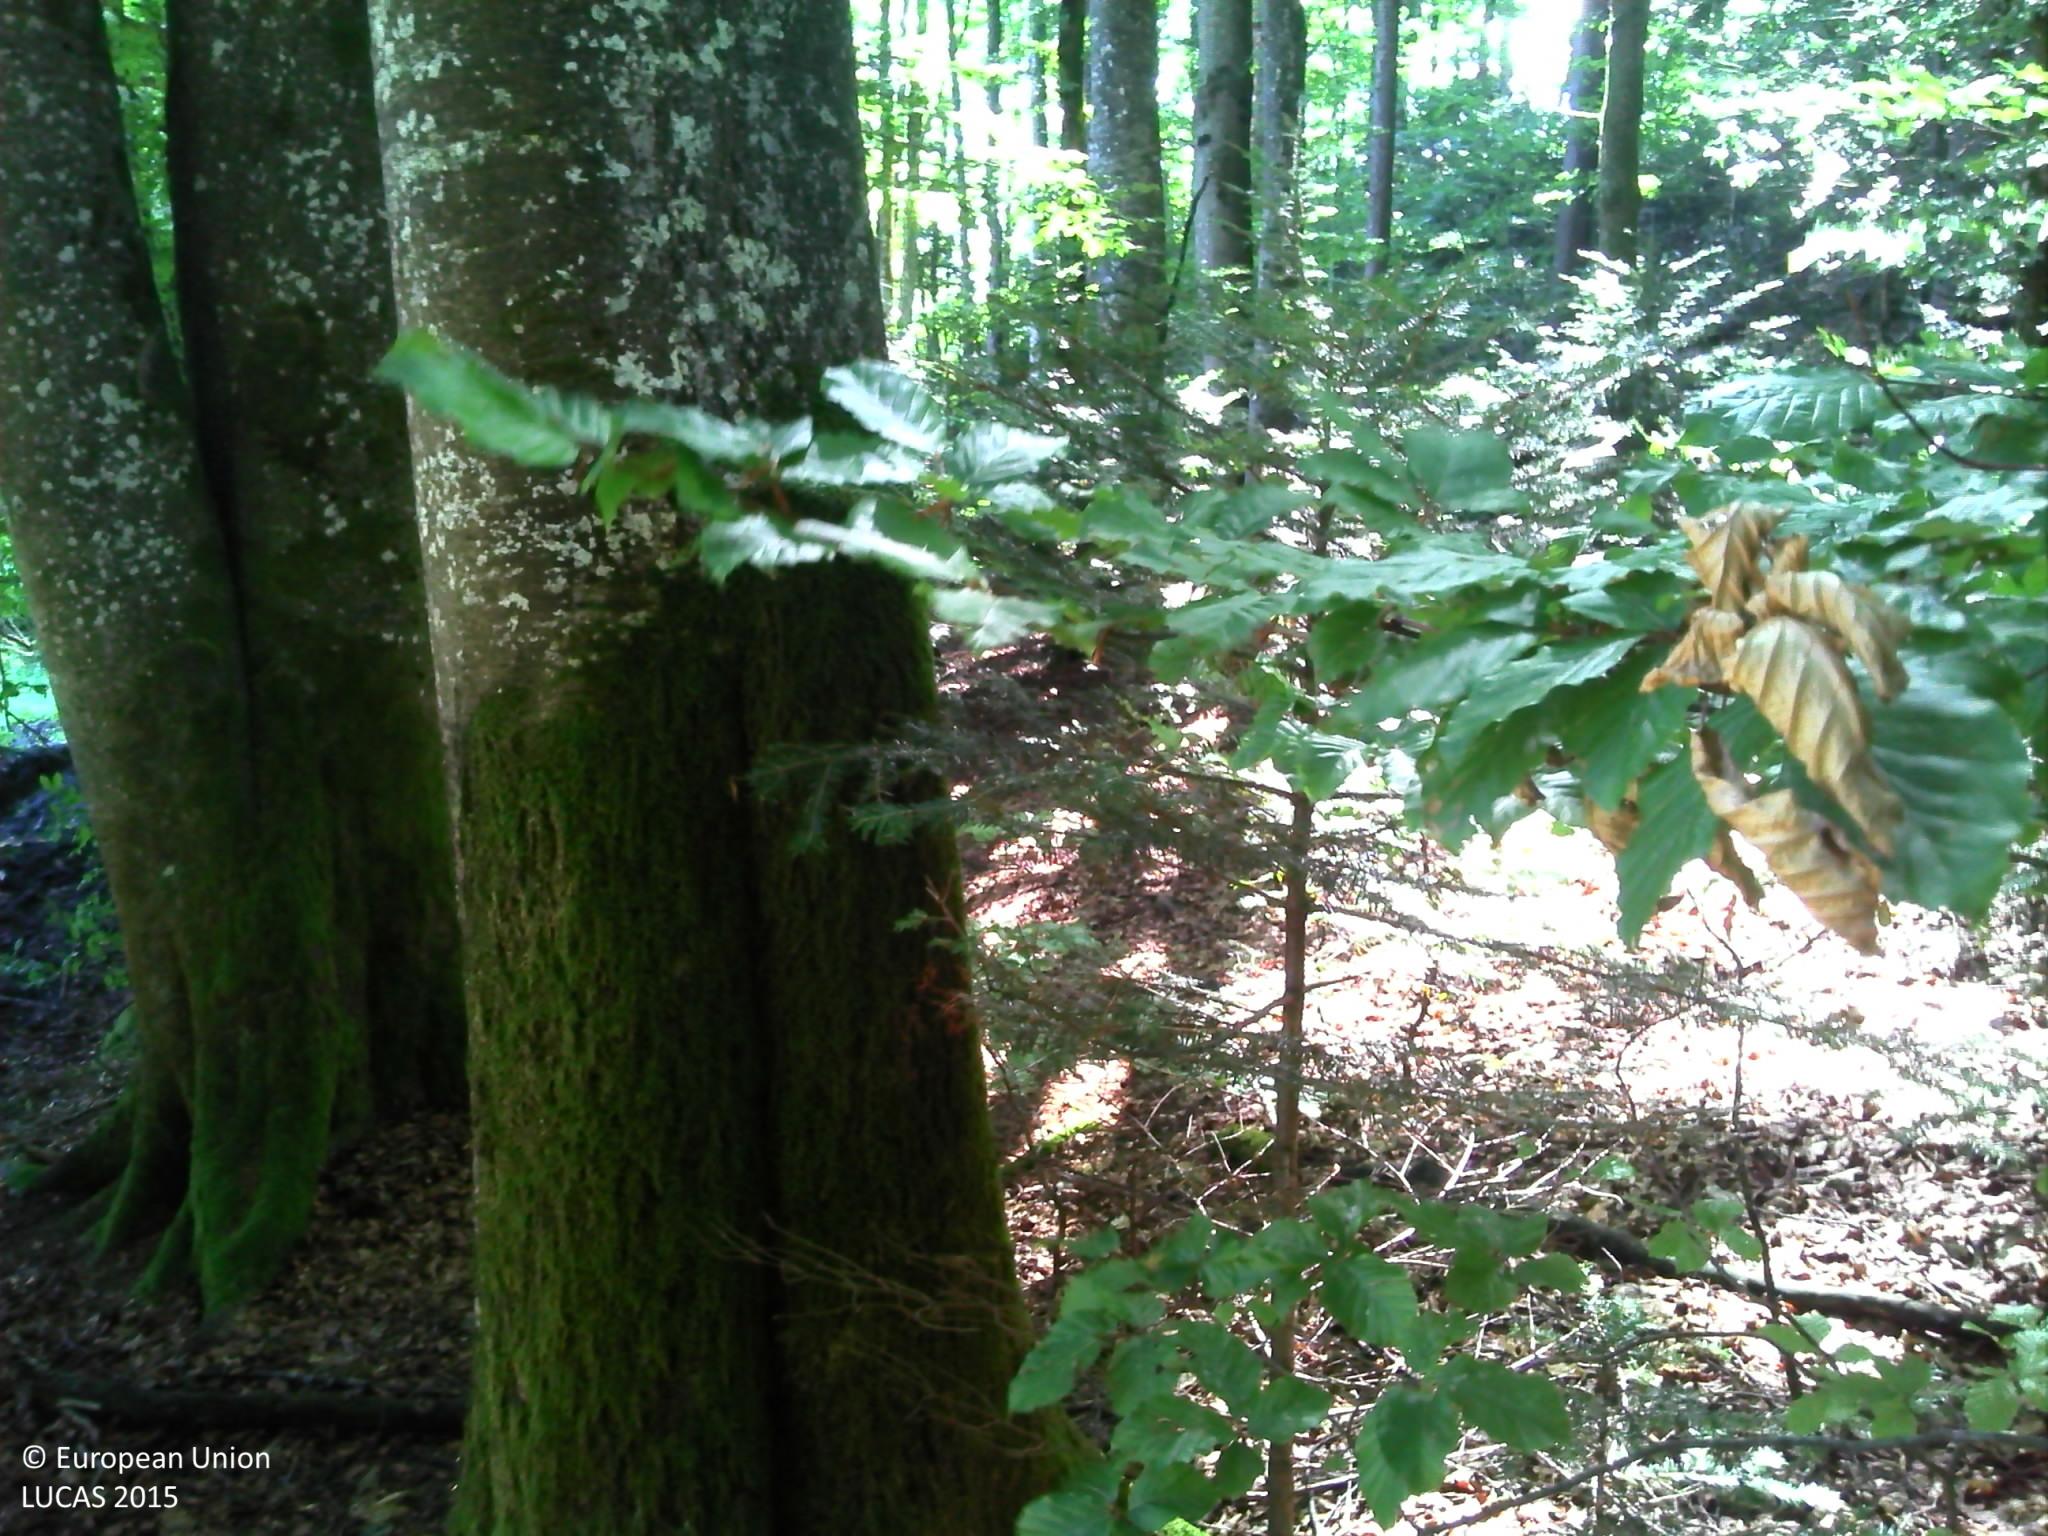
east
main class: Woodland
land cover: Broadleaved woodland
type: beech forest
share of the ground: > 75 %
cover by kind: broadleaved forest trees 70 %, coniferous forest trees 15 %, herbaceous plants 10 %, lichens and mosses 5 %
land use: Forestry
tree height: > 5 m
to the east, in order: Broadleaved woodland; Fences; Tracks; Grassland without tree/shrub cover; Rivers and streams; Broadleaved woodland; Grassland without tree/shrub cover
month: July
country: FR
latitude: 46.0679
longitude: 6.2157
